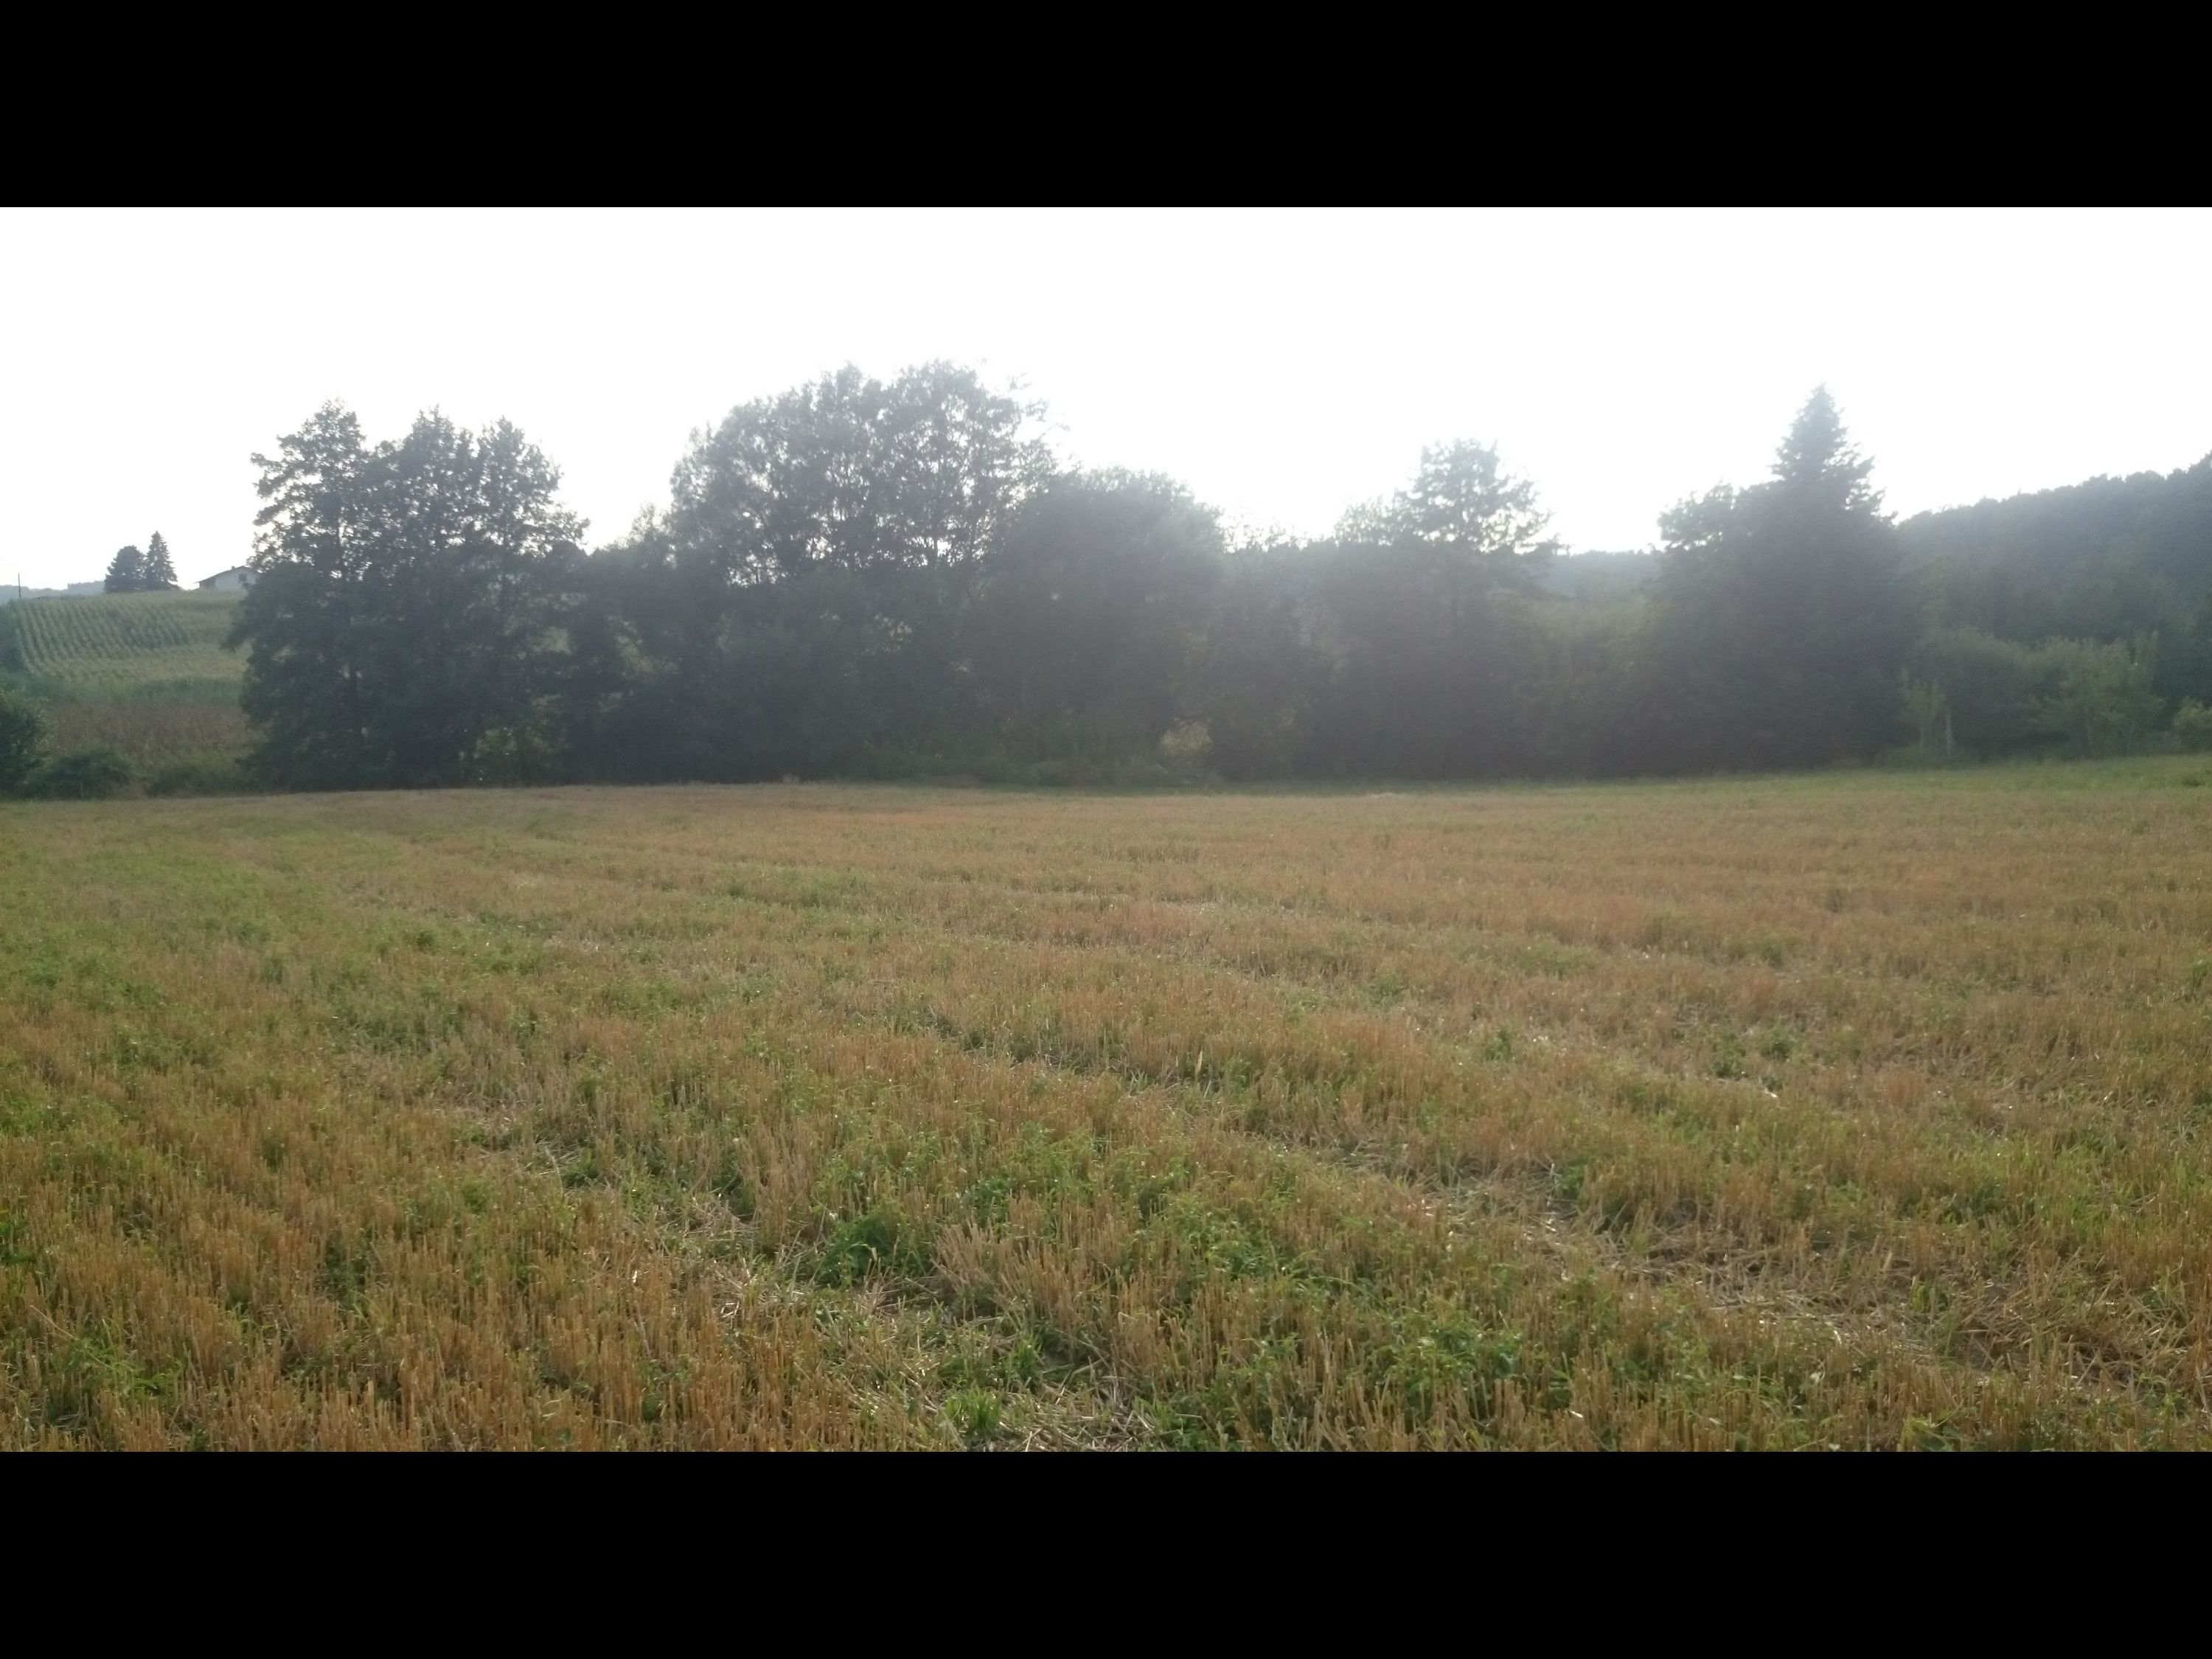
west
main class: Cropland
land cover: Common wheat
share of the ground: > 75 %
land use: Agriculture (excluding fallow land and kitchen gardens)
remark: Harvested field
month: July
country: AT
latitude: 47.0543
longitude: 15.9117
